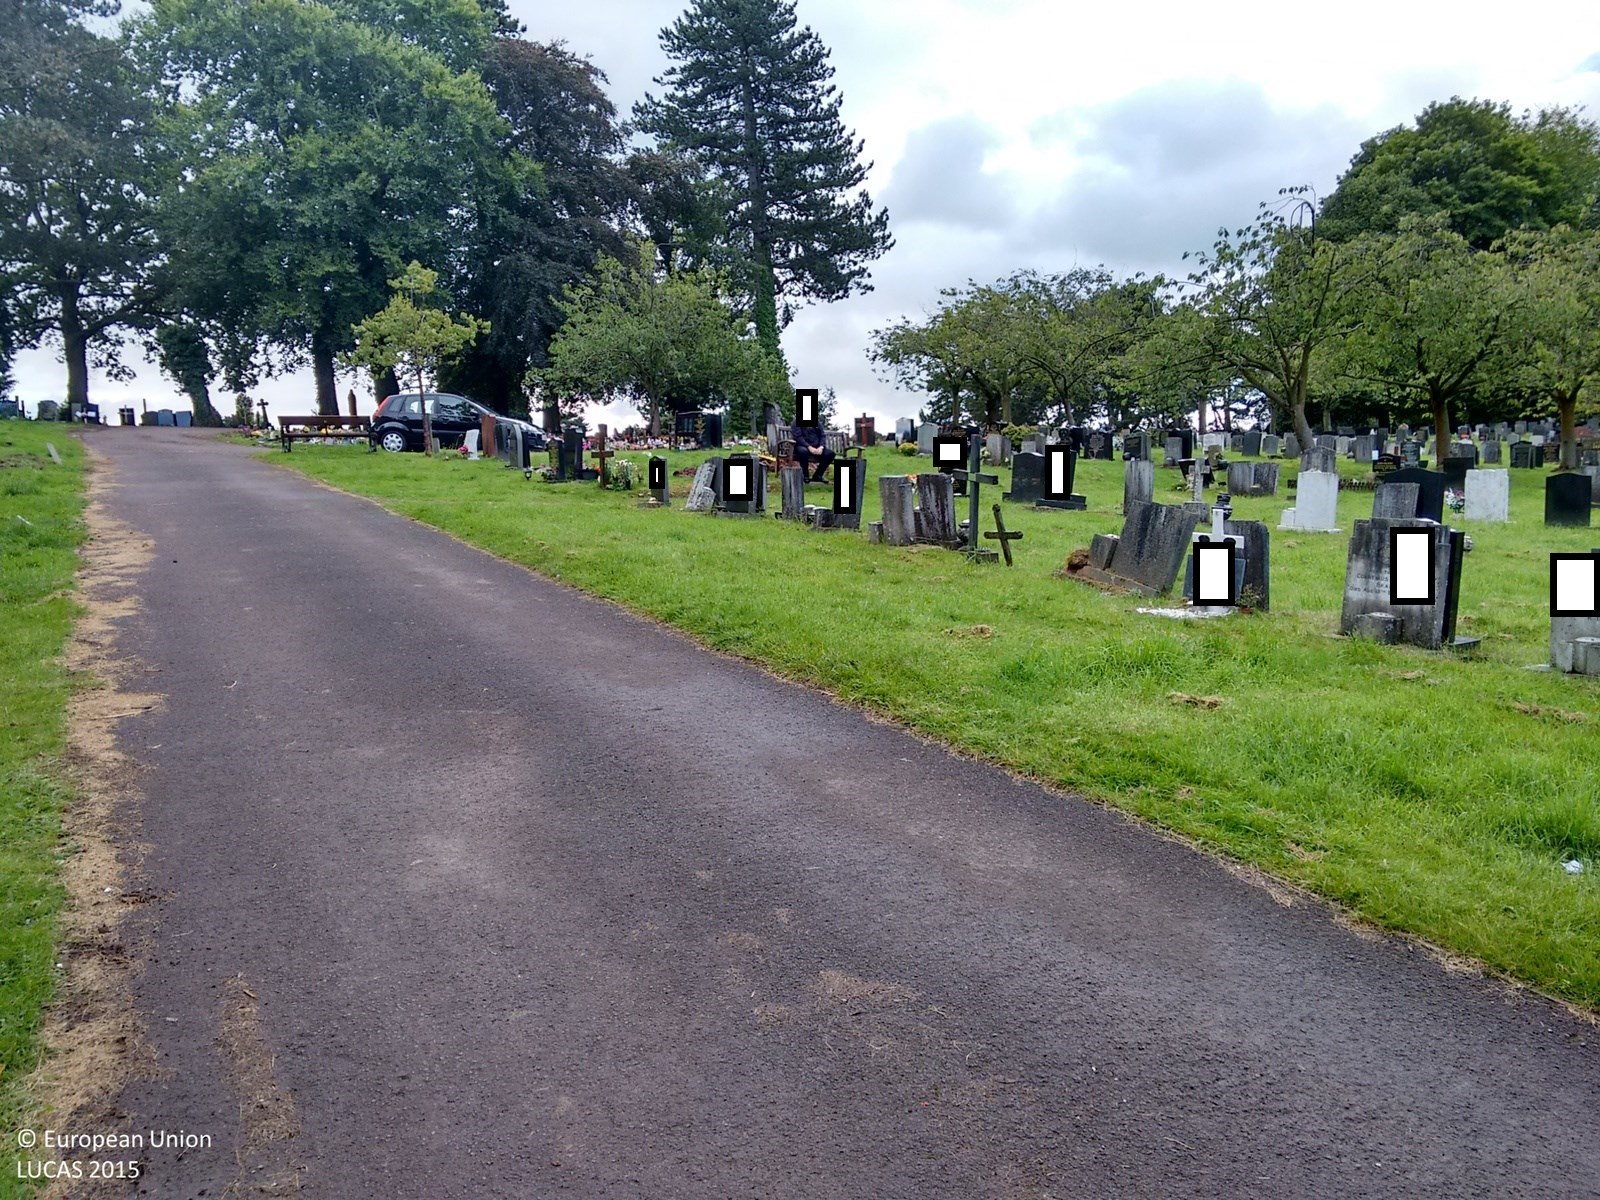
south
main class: Grassland
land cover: Grassland without tree/shrub cover
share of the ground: > 75 %
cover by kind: herbaceous plants 100 %
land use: Community services
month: September
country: GB
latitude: 51.5835
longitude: -3.0210
